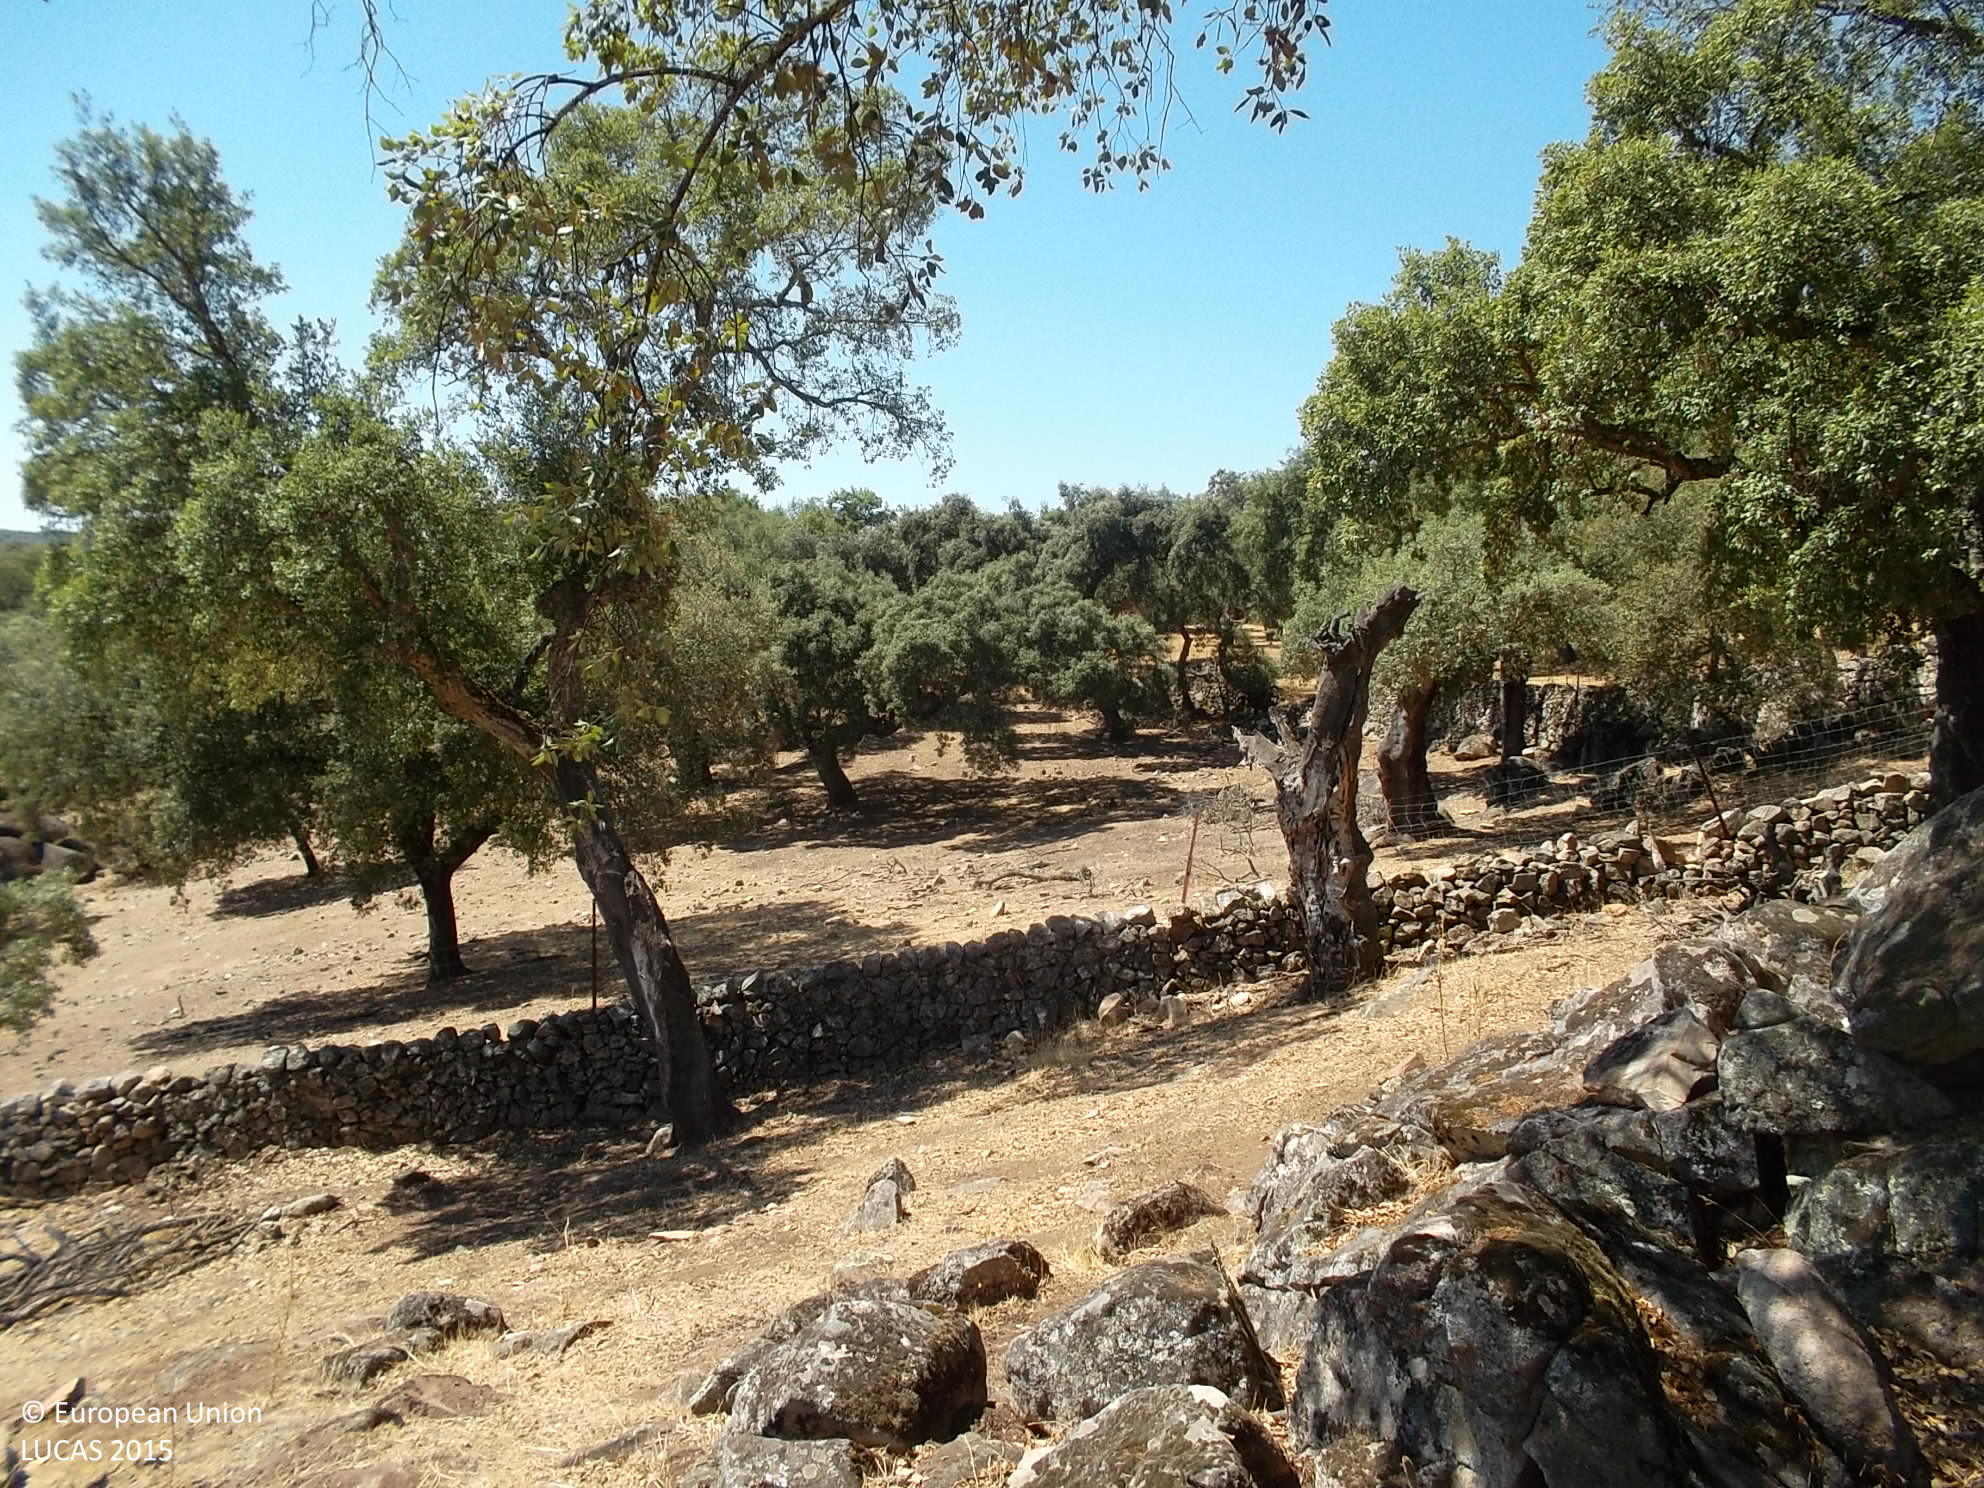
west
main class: Woodland
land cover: Broadleaved woodland
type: broadleaved evergreen forest
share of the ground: 25 - 50 %
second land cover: Grassland without tree/shrub cover
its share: 25 - 50 %
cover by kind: herbaceous plants 45 %, broadleaved forest trees 40 %, consolidated bare surface 15 %
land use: Forestry
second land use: Agriculture (excluding fallow land and kitchen gardens)
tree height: < 5 m
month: August
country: ES
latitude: 38.4546
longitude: -6.7068
